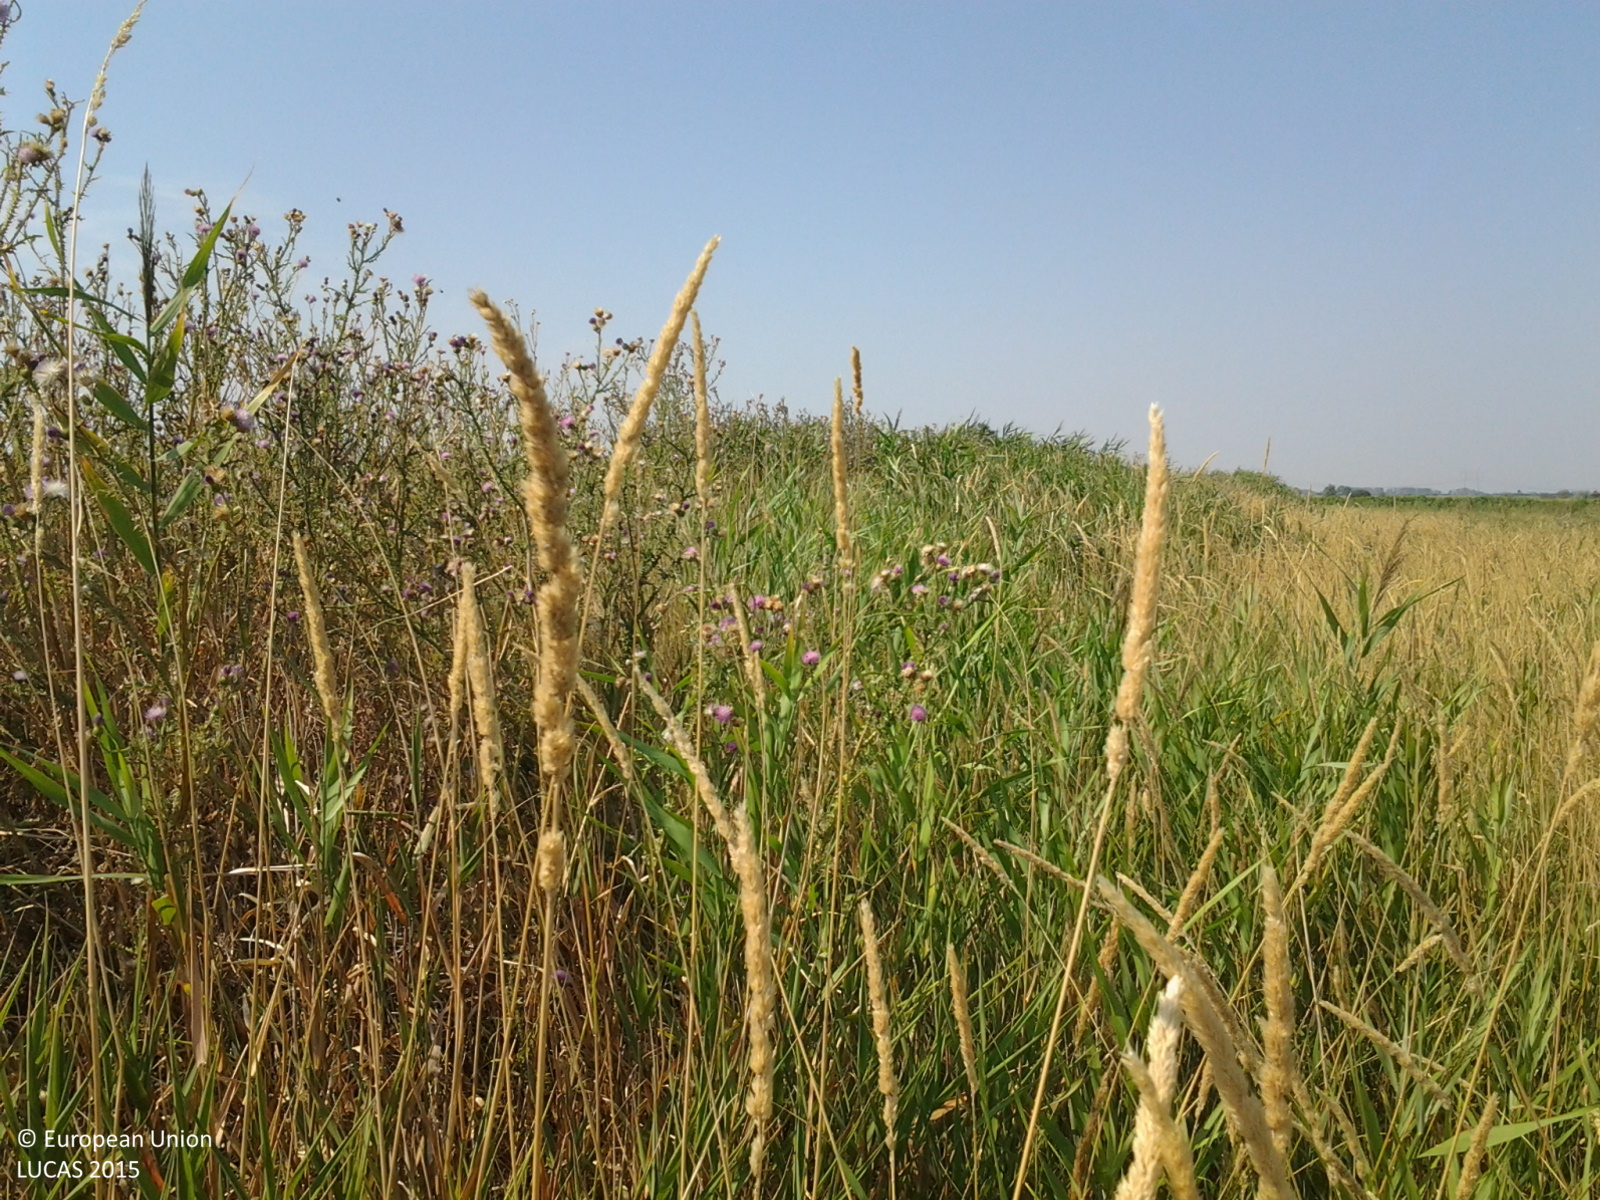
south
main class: Grassland
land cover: Spontaneously vegetated surfaces
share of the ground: > 75 %
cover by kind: herbaceous plants 100 %
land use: Semi-natural and natural areas not in use
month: July
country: HU
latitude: 47.2964
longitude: 20.5707
